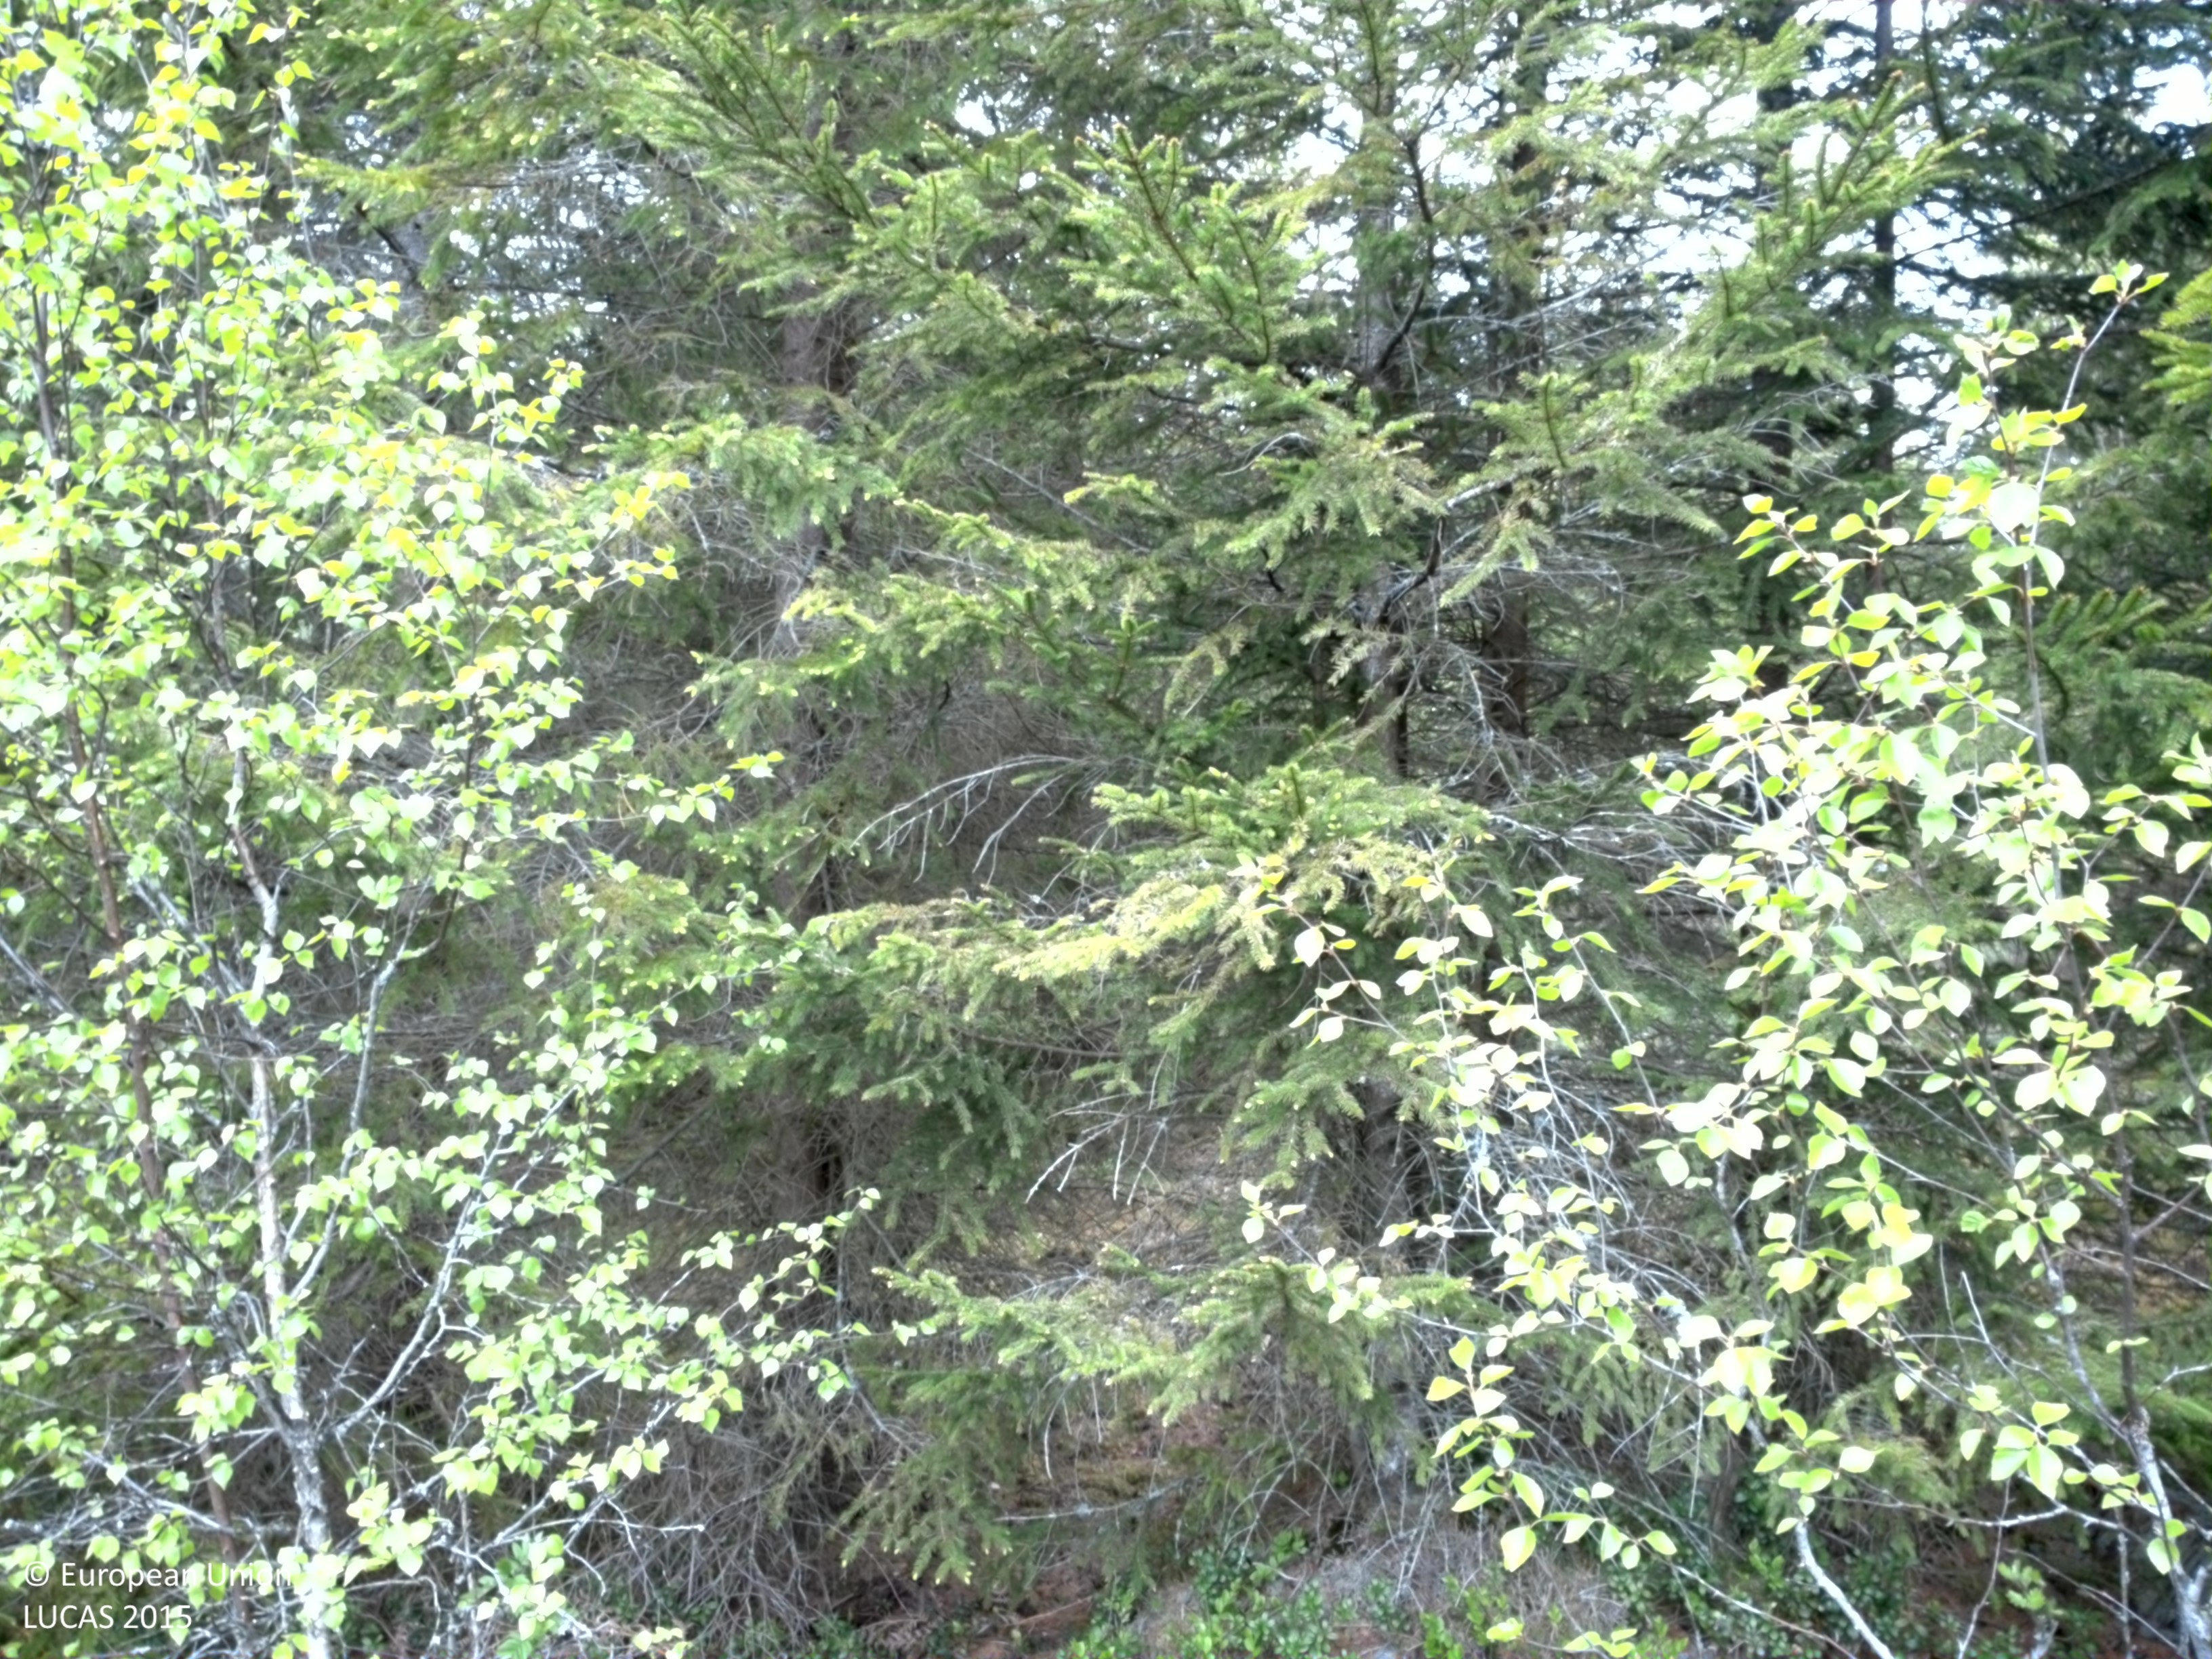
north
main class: Woodland
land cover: Spruce dominated coniferous woodland
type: boreal forest
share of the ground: 50 - 75 %
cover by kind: coniferous forest trees 50 %, shrubs 30 %, broadleaved forest trees 10 %, herbaceous plants 5 %, lichens and mosses 5 %
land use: Forestry
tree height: > 5 m
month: May
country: SE
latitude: 56.8933
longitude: 15.2014
